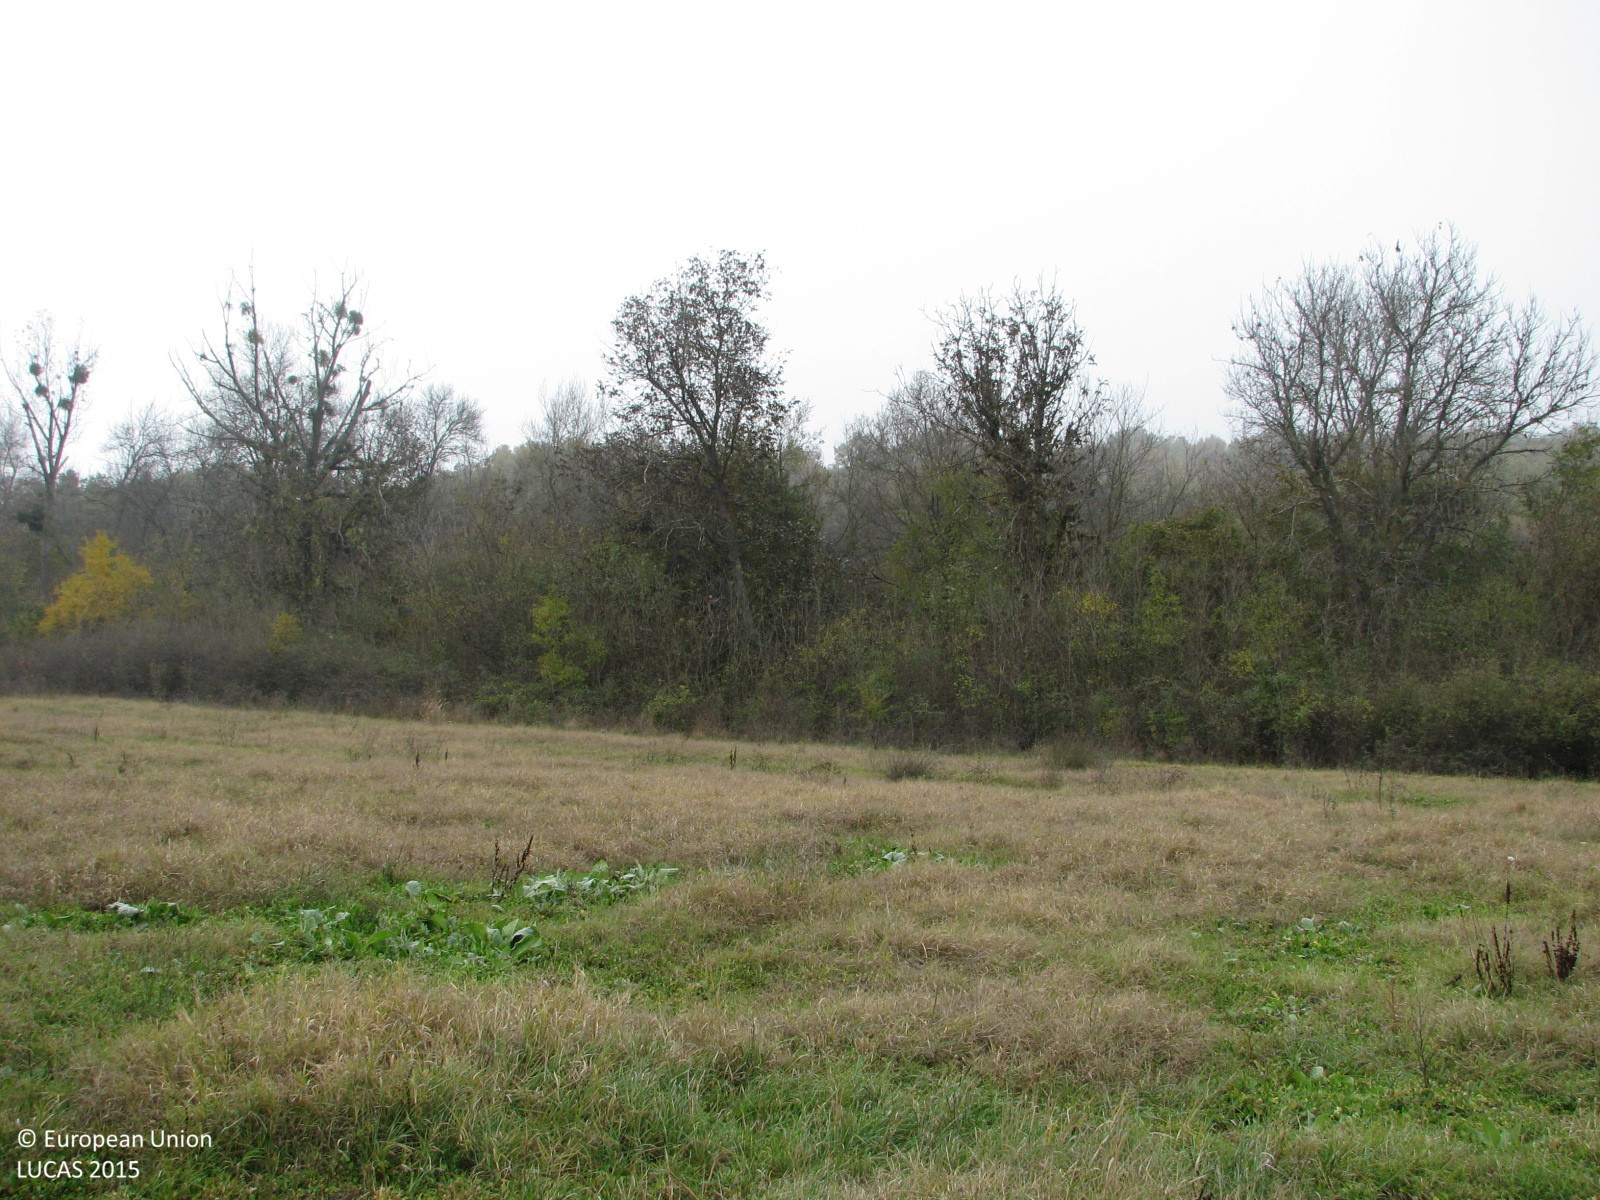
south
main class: Grassland
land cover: Grassland without tree/shrub cover
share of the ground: > 75 %
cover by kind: herbaceous plants 100 %
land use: Agriculture (excluding fallow land and kitchen gardens)
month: November
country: BG
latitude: 42.0859
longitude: 26.6897
